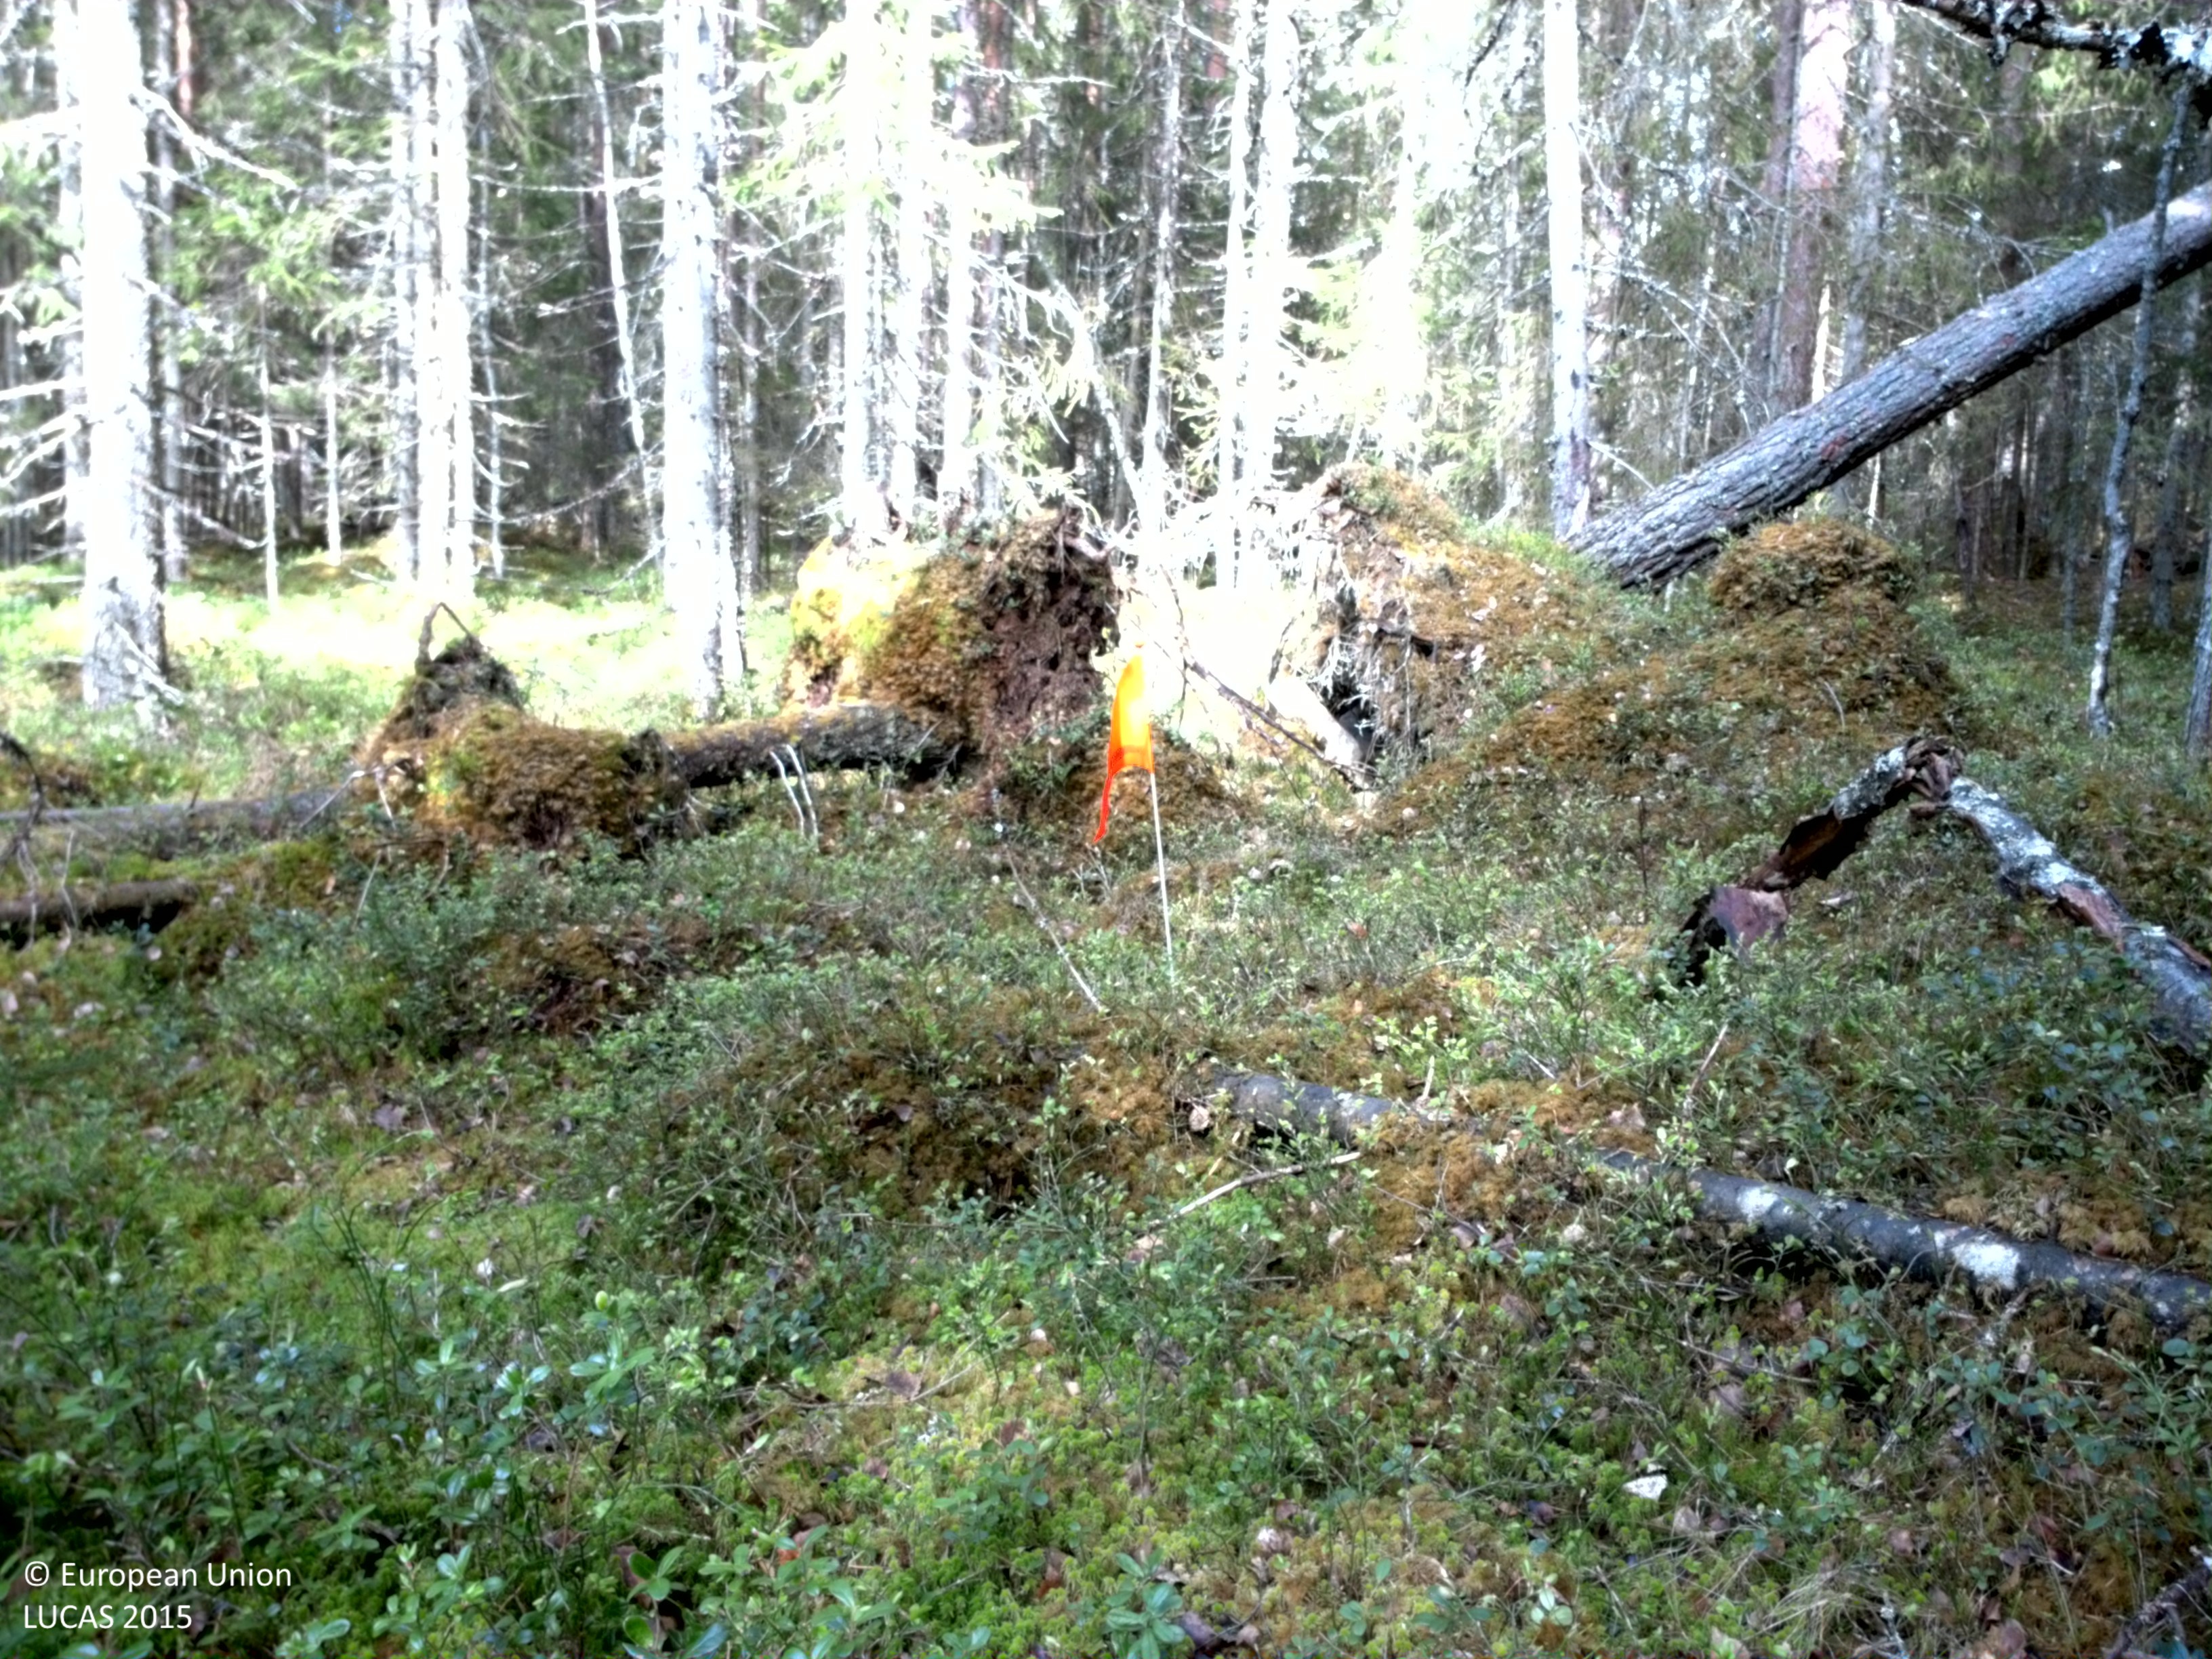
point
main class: Woodland
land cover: Spruce dominated coniferous woodland
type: boreal forest
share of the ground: > 75 %
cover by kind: coniferous forest trees 80 %, shrubs 10 %, herbaceous plants 5 %, lichens and mosses 5 %
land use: Forestry
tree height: > 5 m
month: May
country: SE
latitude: 61.1469
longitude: 15.2798
